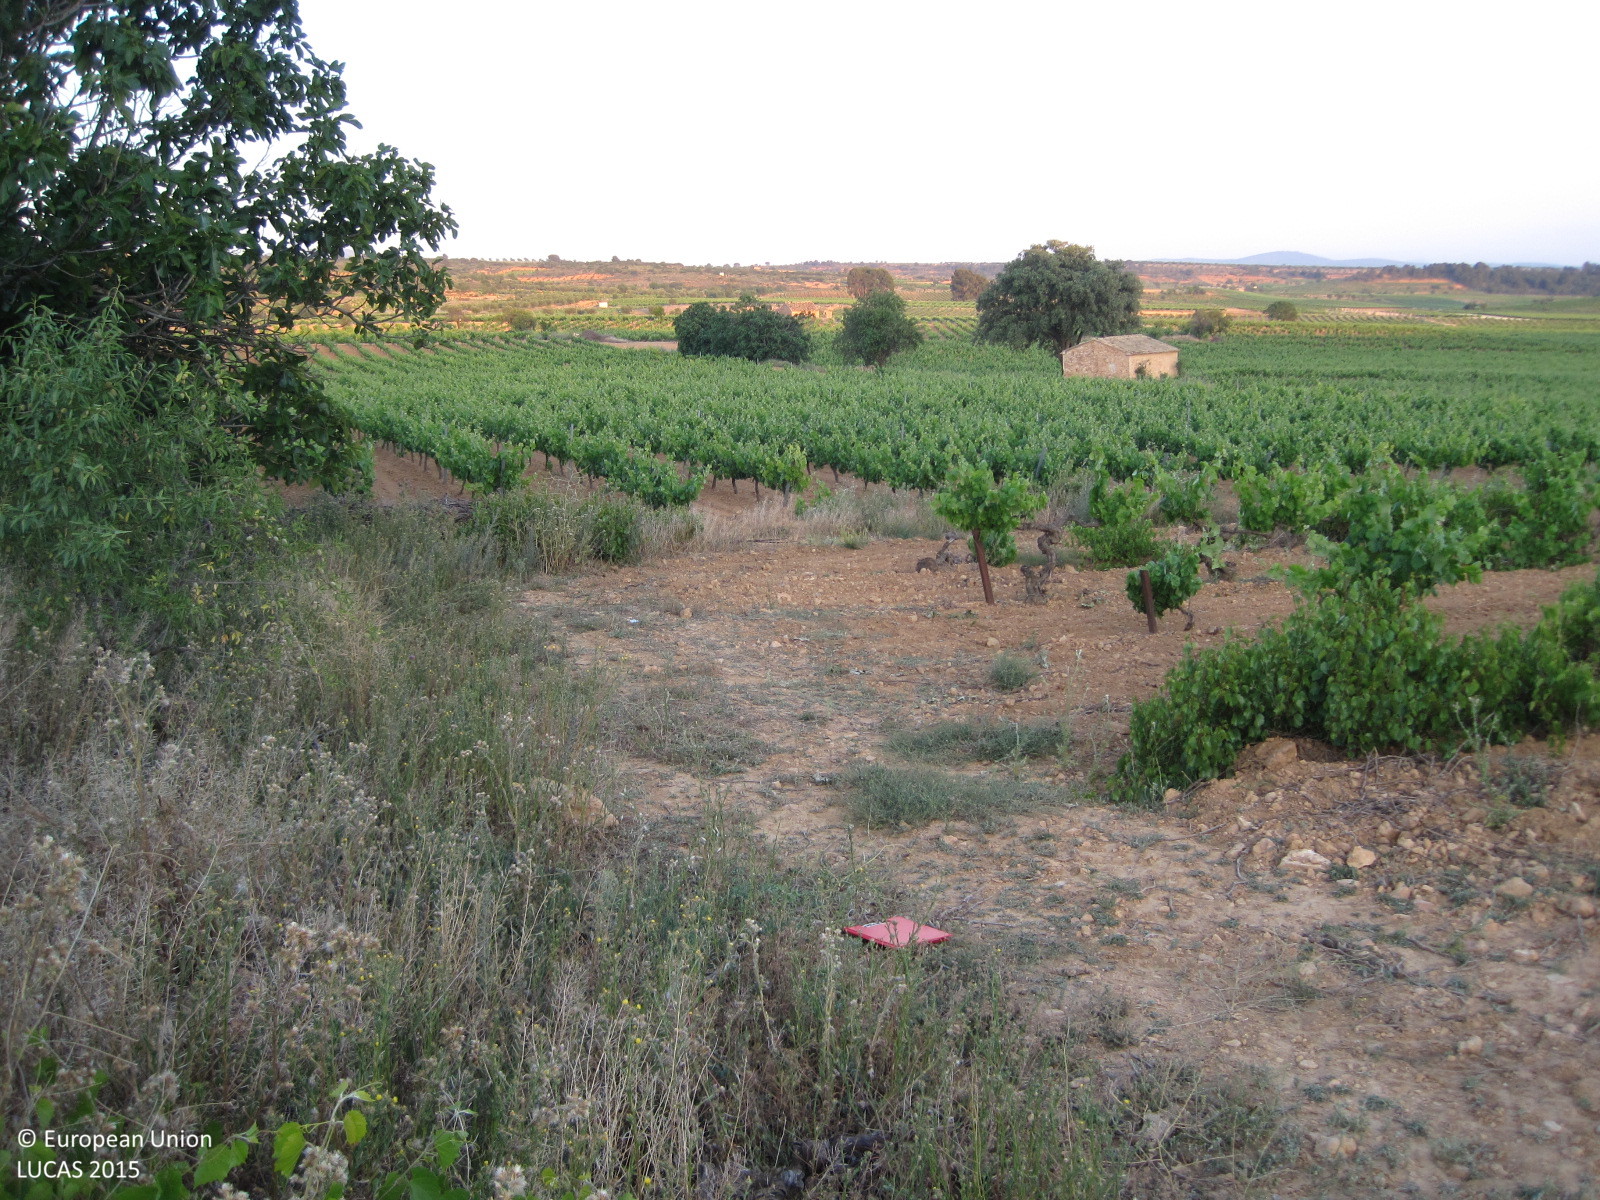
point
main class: Cropland
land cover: Vineyards
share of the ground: 25 - 50 %
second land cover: Other bare soil
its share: > 75 %
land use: Agriculture (excluding fallow land and kitchen gardens)
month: May
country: ES
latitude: 39.5425
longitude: -1.1144
